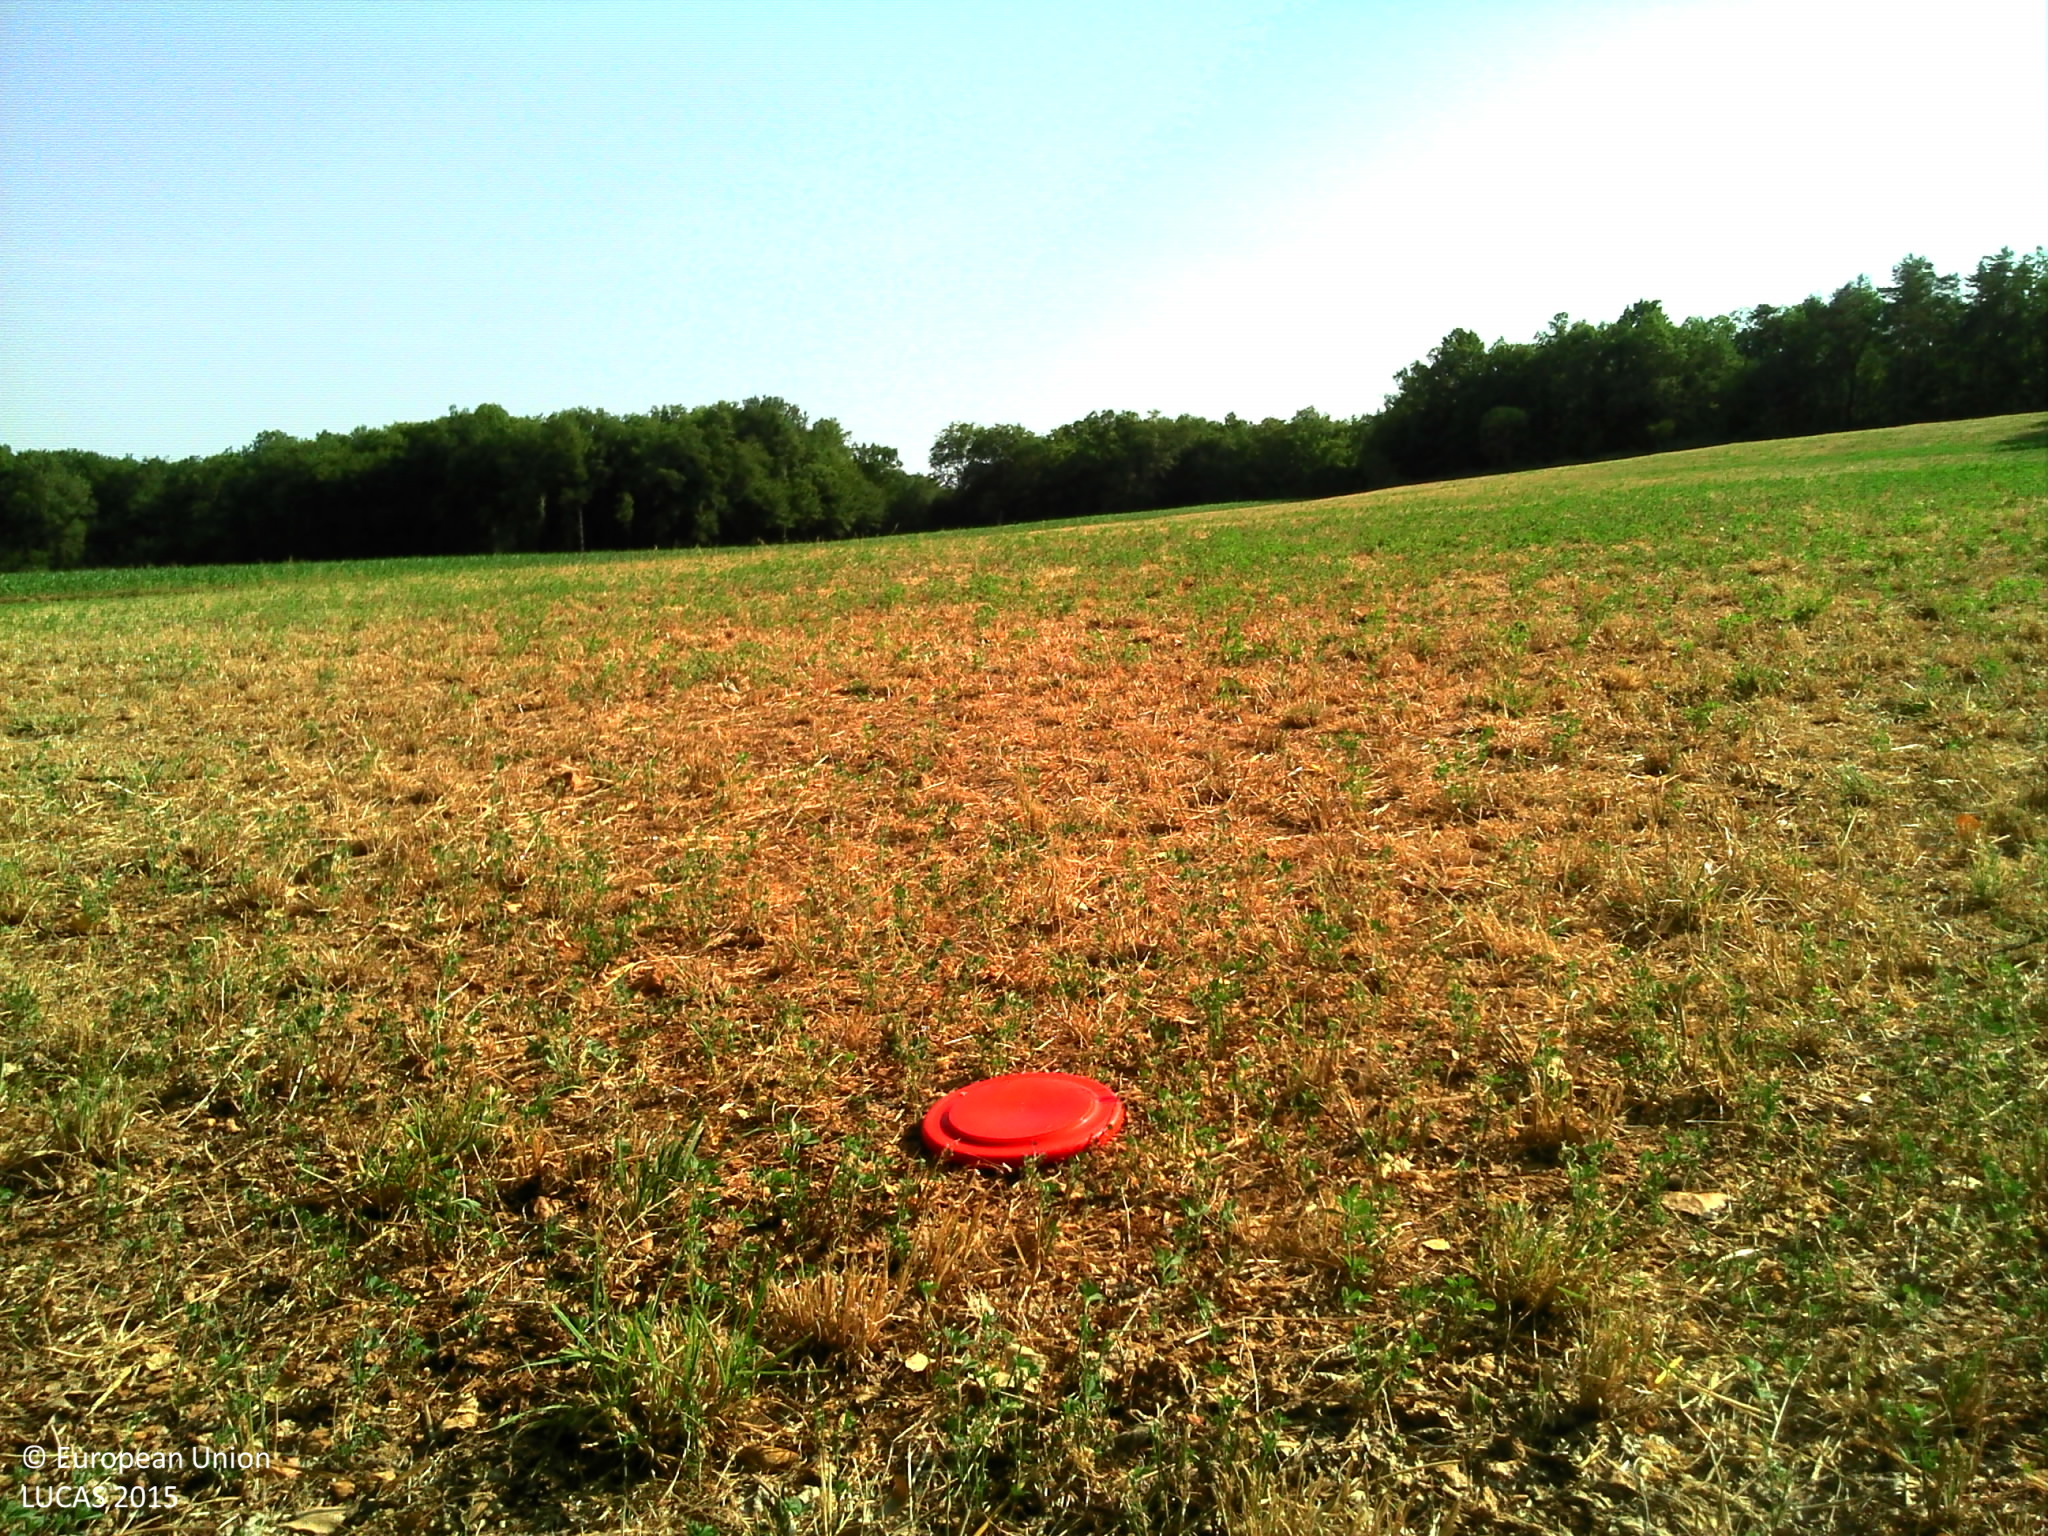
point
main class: Cropland
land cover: Temporary grasslands
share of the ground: > 75 %
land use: Agriculture (excluding fallow land and kitchen gardens)
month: July
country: FR
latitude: 45.2378
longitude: 1.1136
